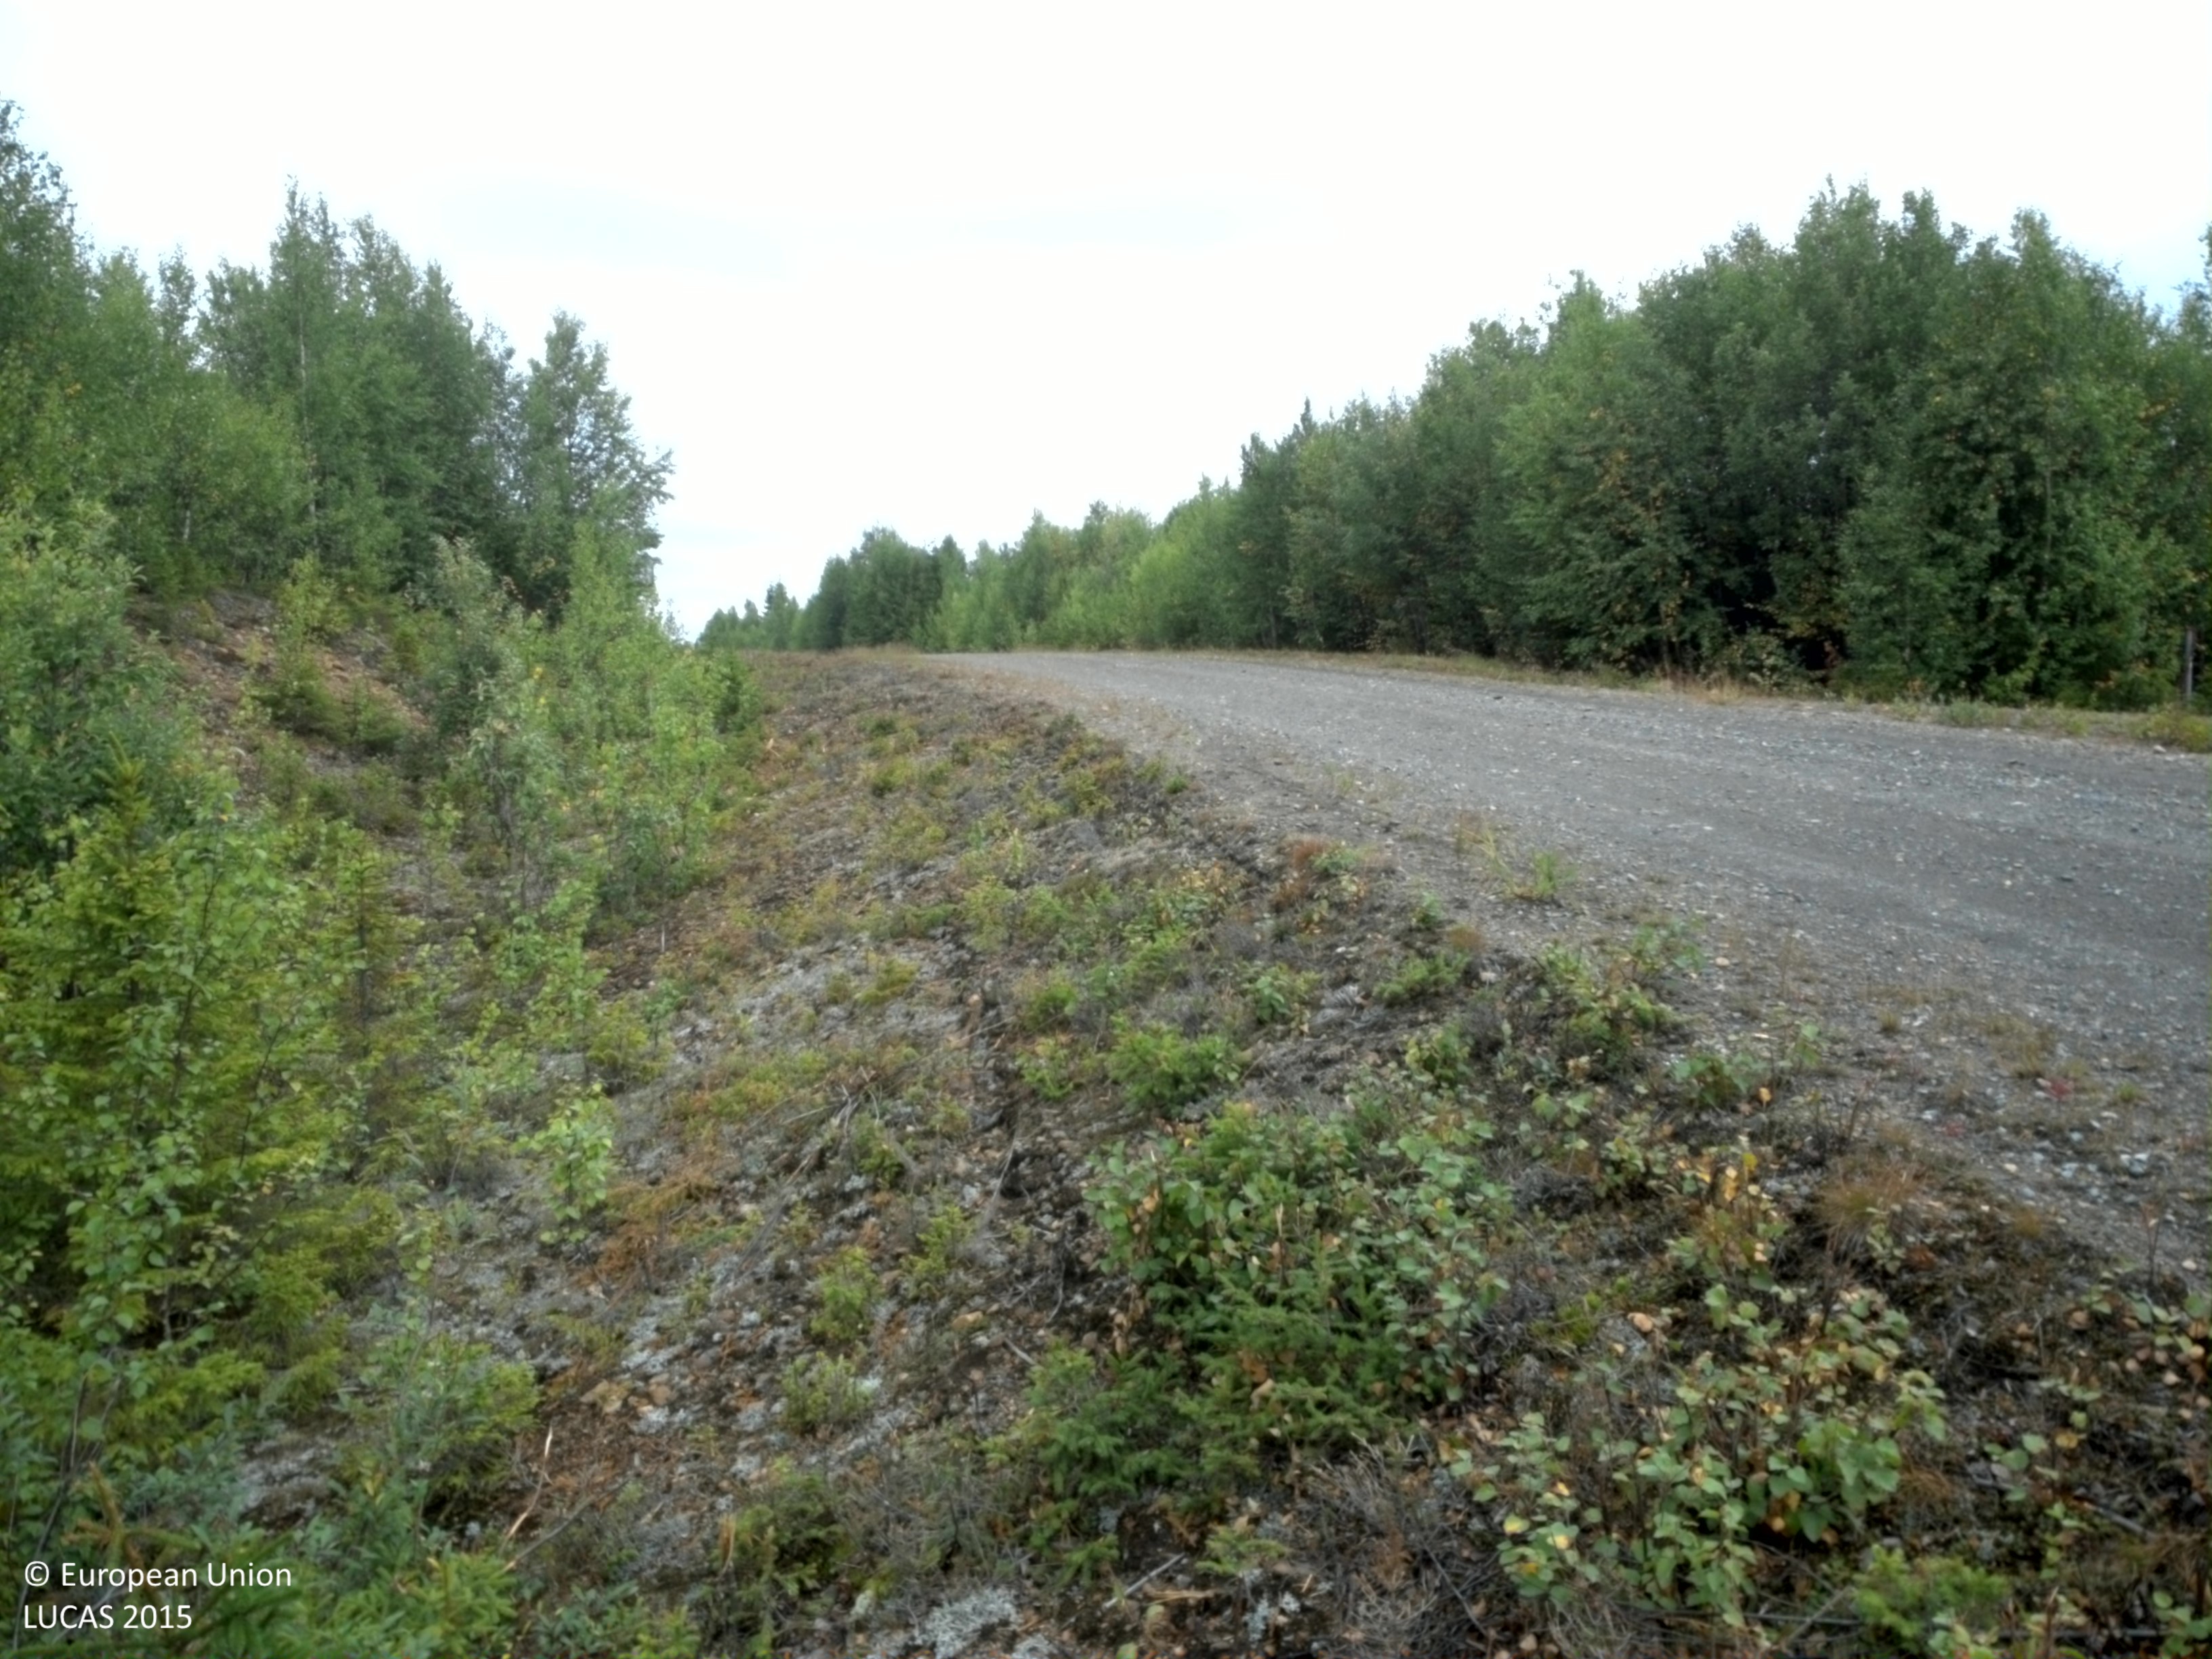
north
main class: Woodland
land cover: Spruce dominated mixed woodland
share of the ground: 10 - 25 %
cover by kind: unconsolidated bare surface 30 %, lichens and mosses 25 %, herbaceous plants 20 %, coniferous forest trees 10 %, shrubs 10 %, broadleaved forest trees 5 %
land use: Road transport
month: August
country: SE
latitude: 64.8099
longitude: 16.4727
